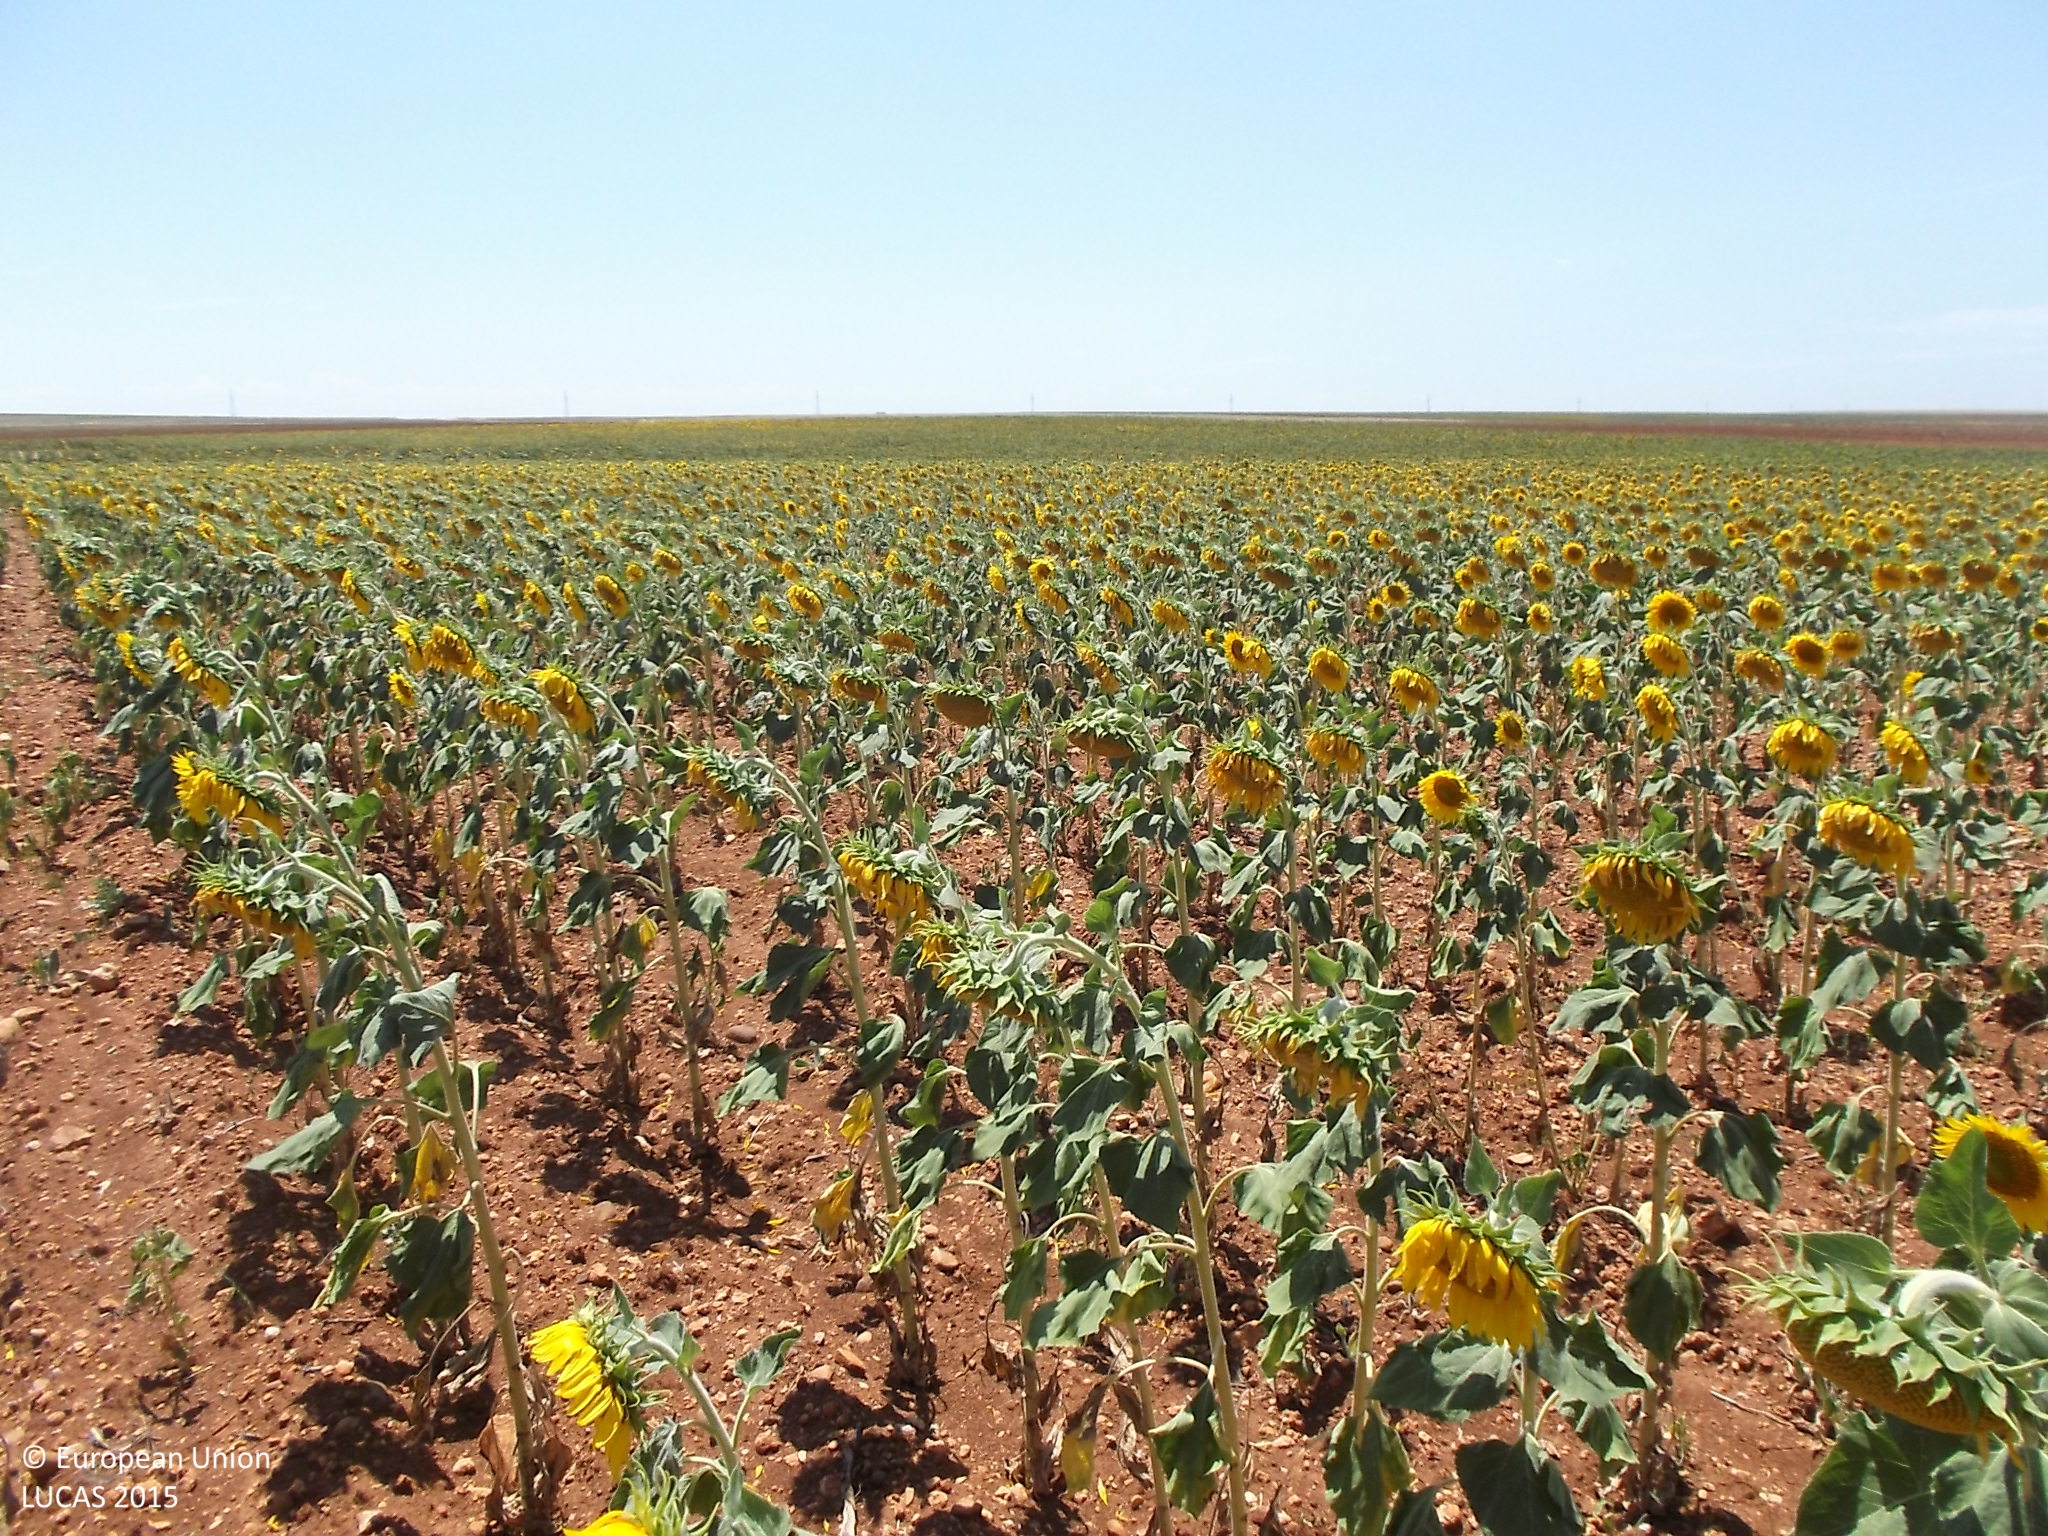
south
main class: Cropland
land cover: Sunflower
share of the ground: > 75 %
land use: Agriculture (excluding fallow land and kitchen gardens)
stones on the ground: < 10 %
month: July
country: ES
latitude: 41.6448
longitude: -5.5607
